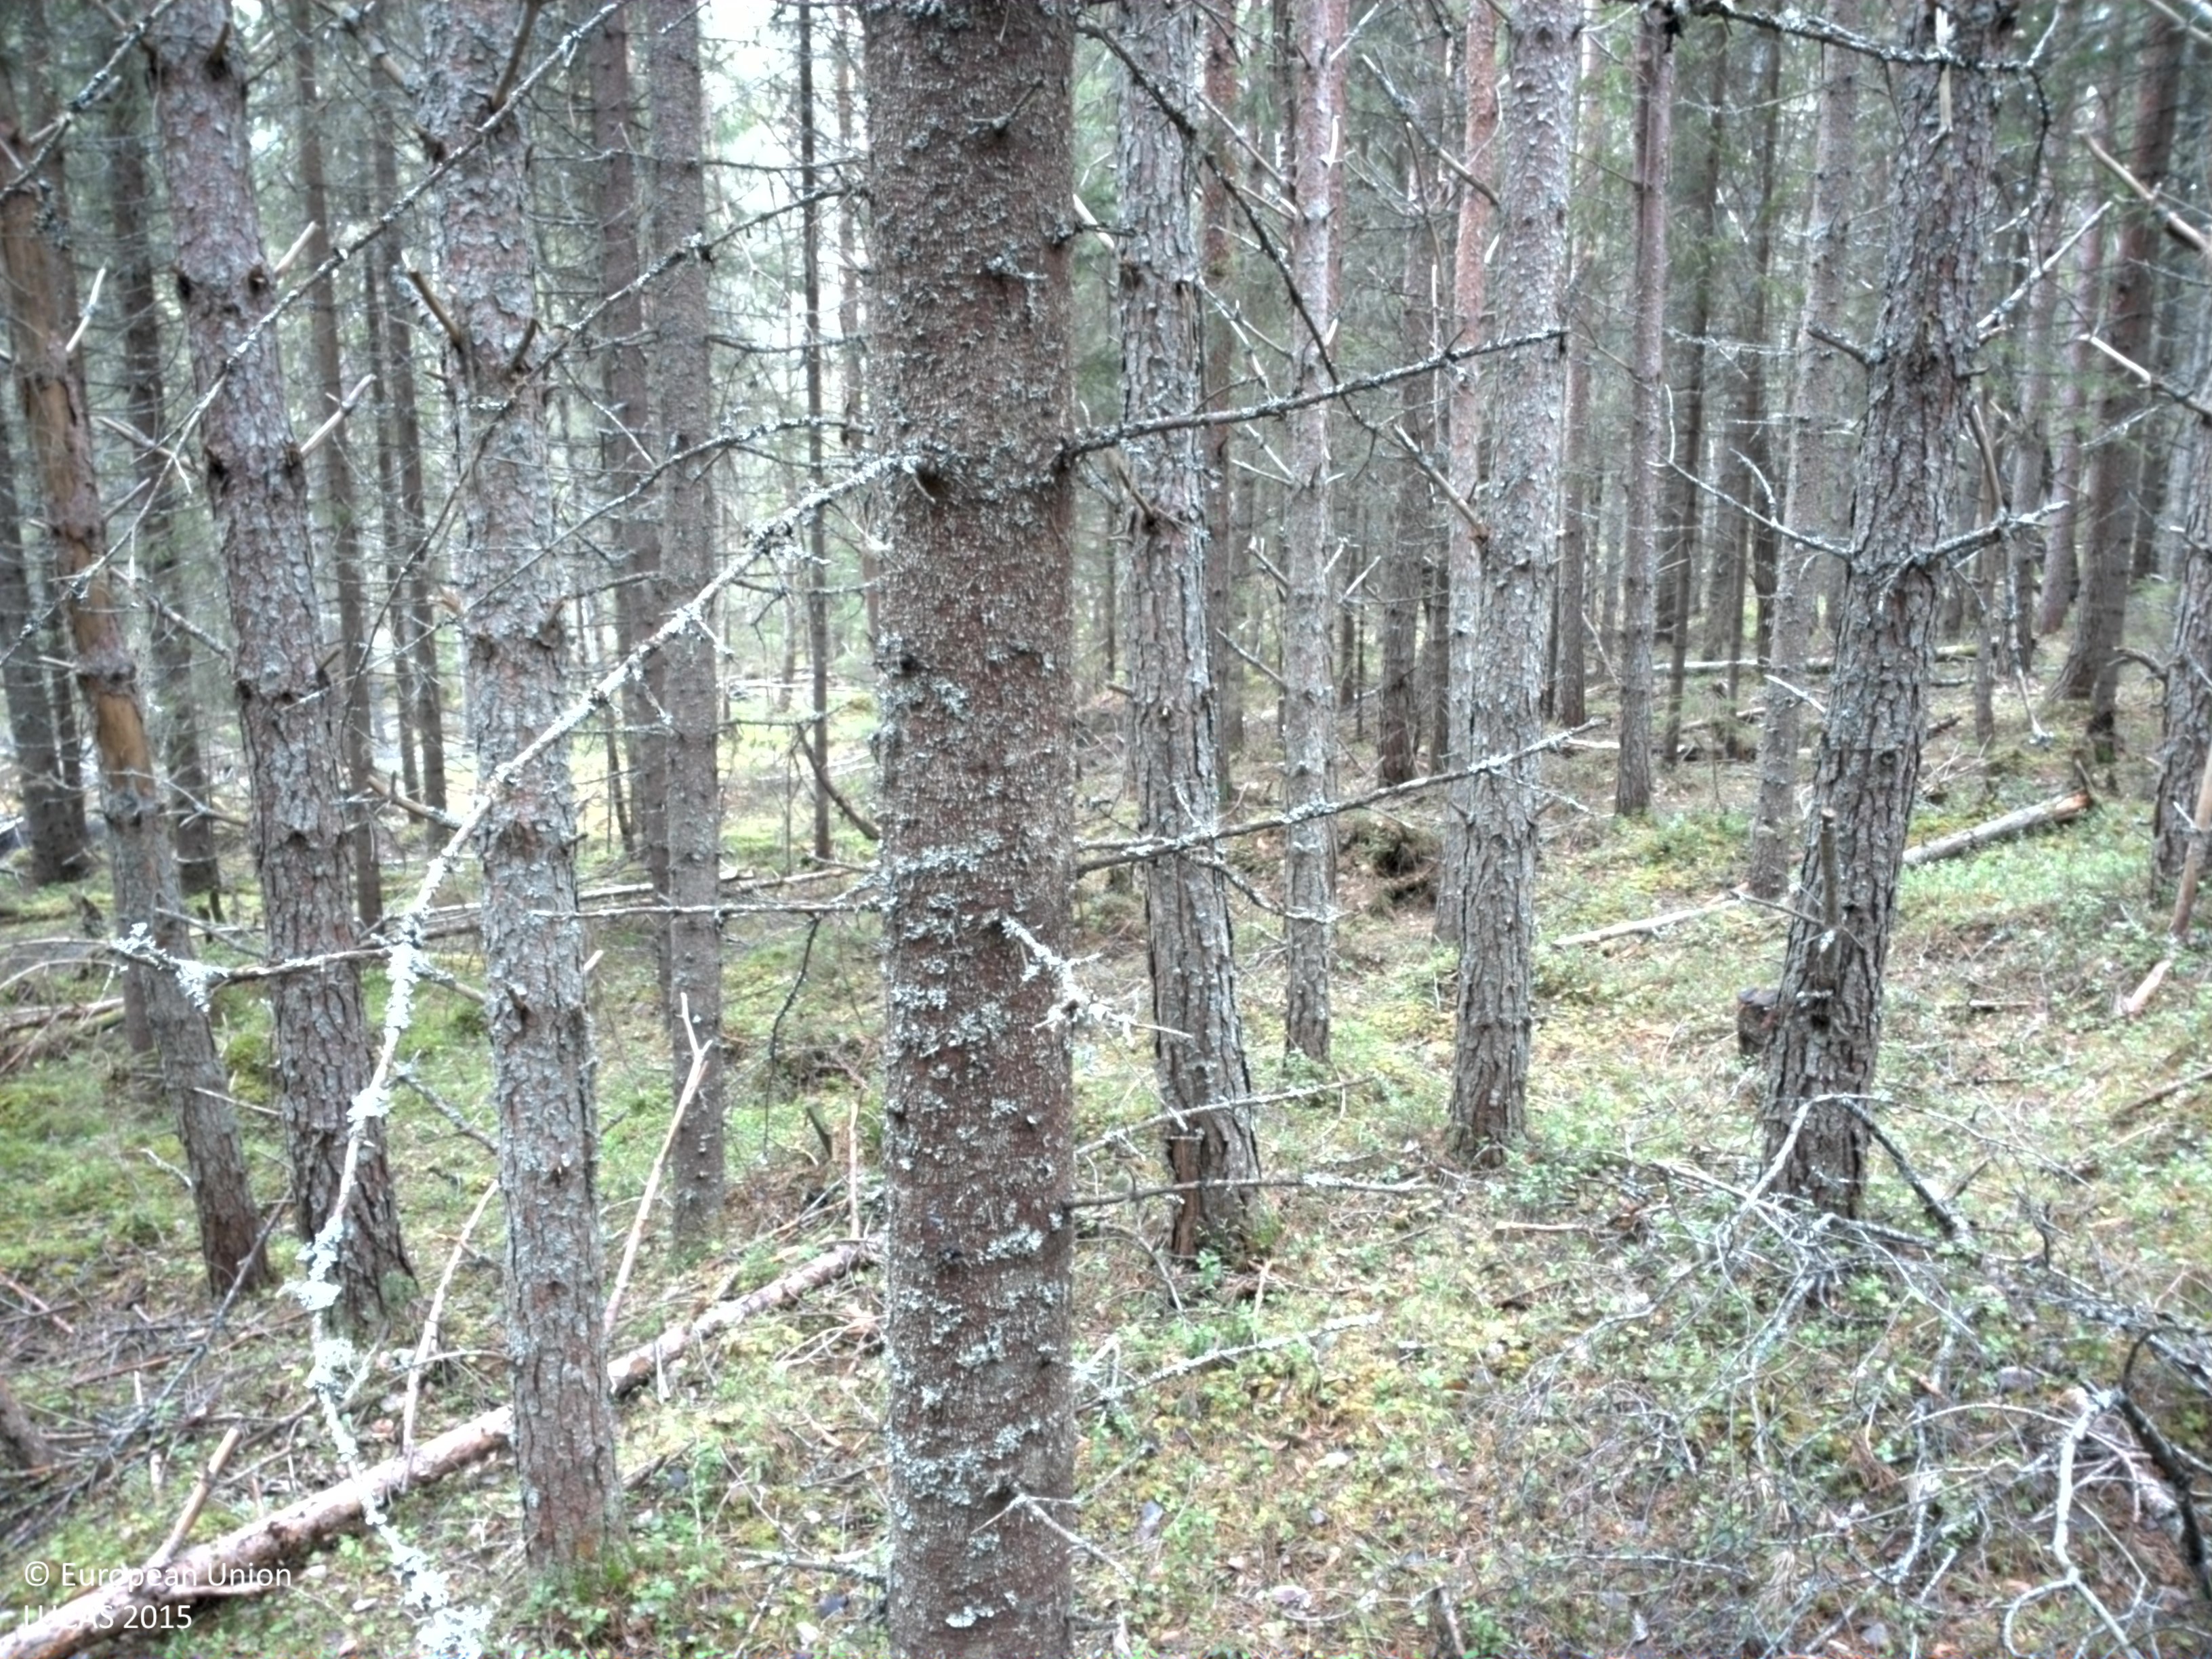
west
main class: Woodland
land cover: Pine dominated mixed woodland
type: boreal forest
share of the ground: > 75 %
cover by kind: coniferous forest trees 60 %, broadleaved forest trees 20 %, lichens and mosses 10 %, shrubs 5 %, herbaceous plants 5 %
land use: Forestry
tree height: > 5 m
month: June
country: SE
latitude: 63.4819
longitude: 13.9347
